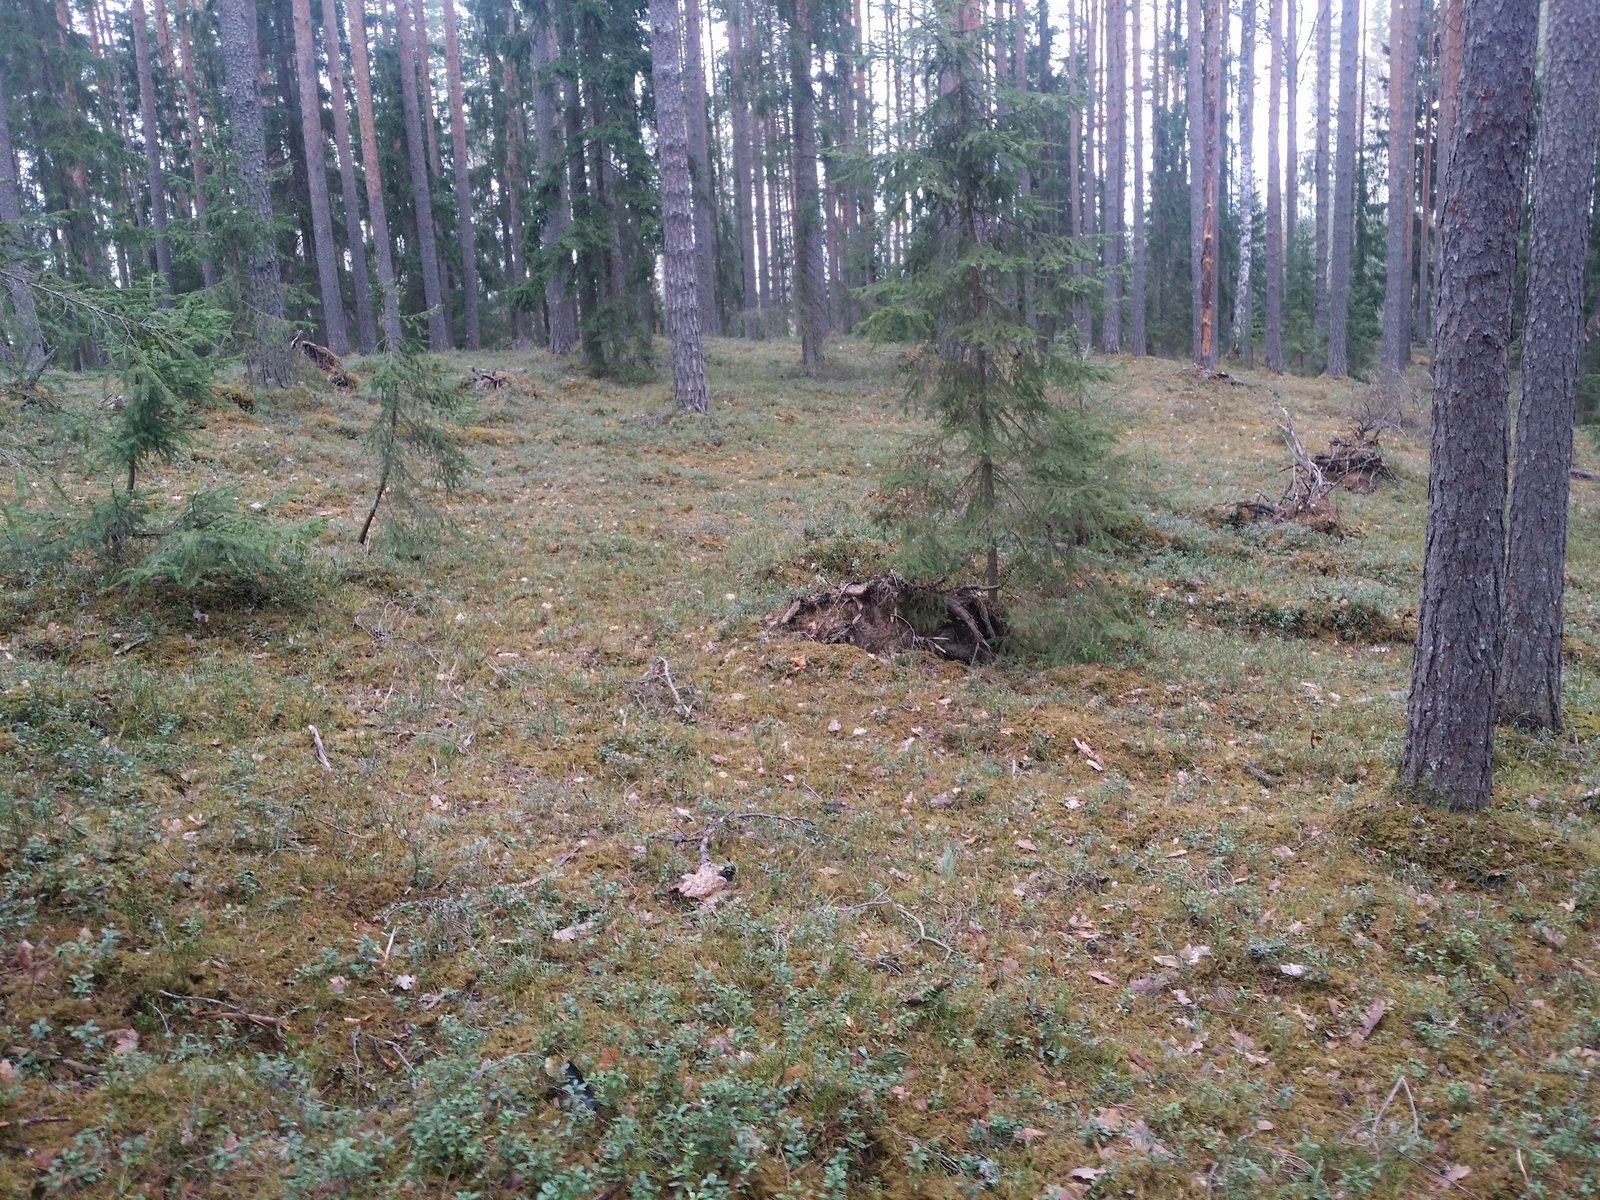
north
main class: Woodland
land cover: Other coniferous woodland
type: hemiboreal forest and nemoral coniferous forest and mixed broadleaved-coniferous forest
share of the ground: > 75 %
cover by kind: coniferous forest trees 90 %, lichens and mosses 10 %
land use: Forestry
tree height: > 5 m
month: May
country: LV
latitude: 57.4483
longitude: 26.0436
